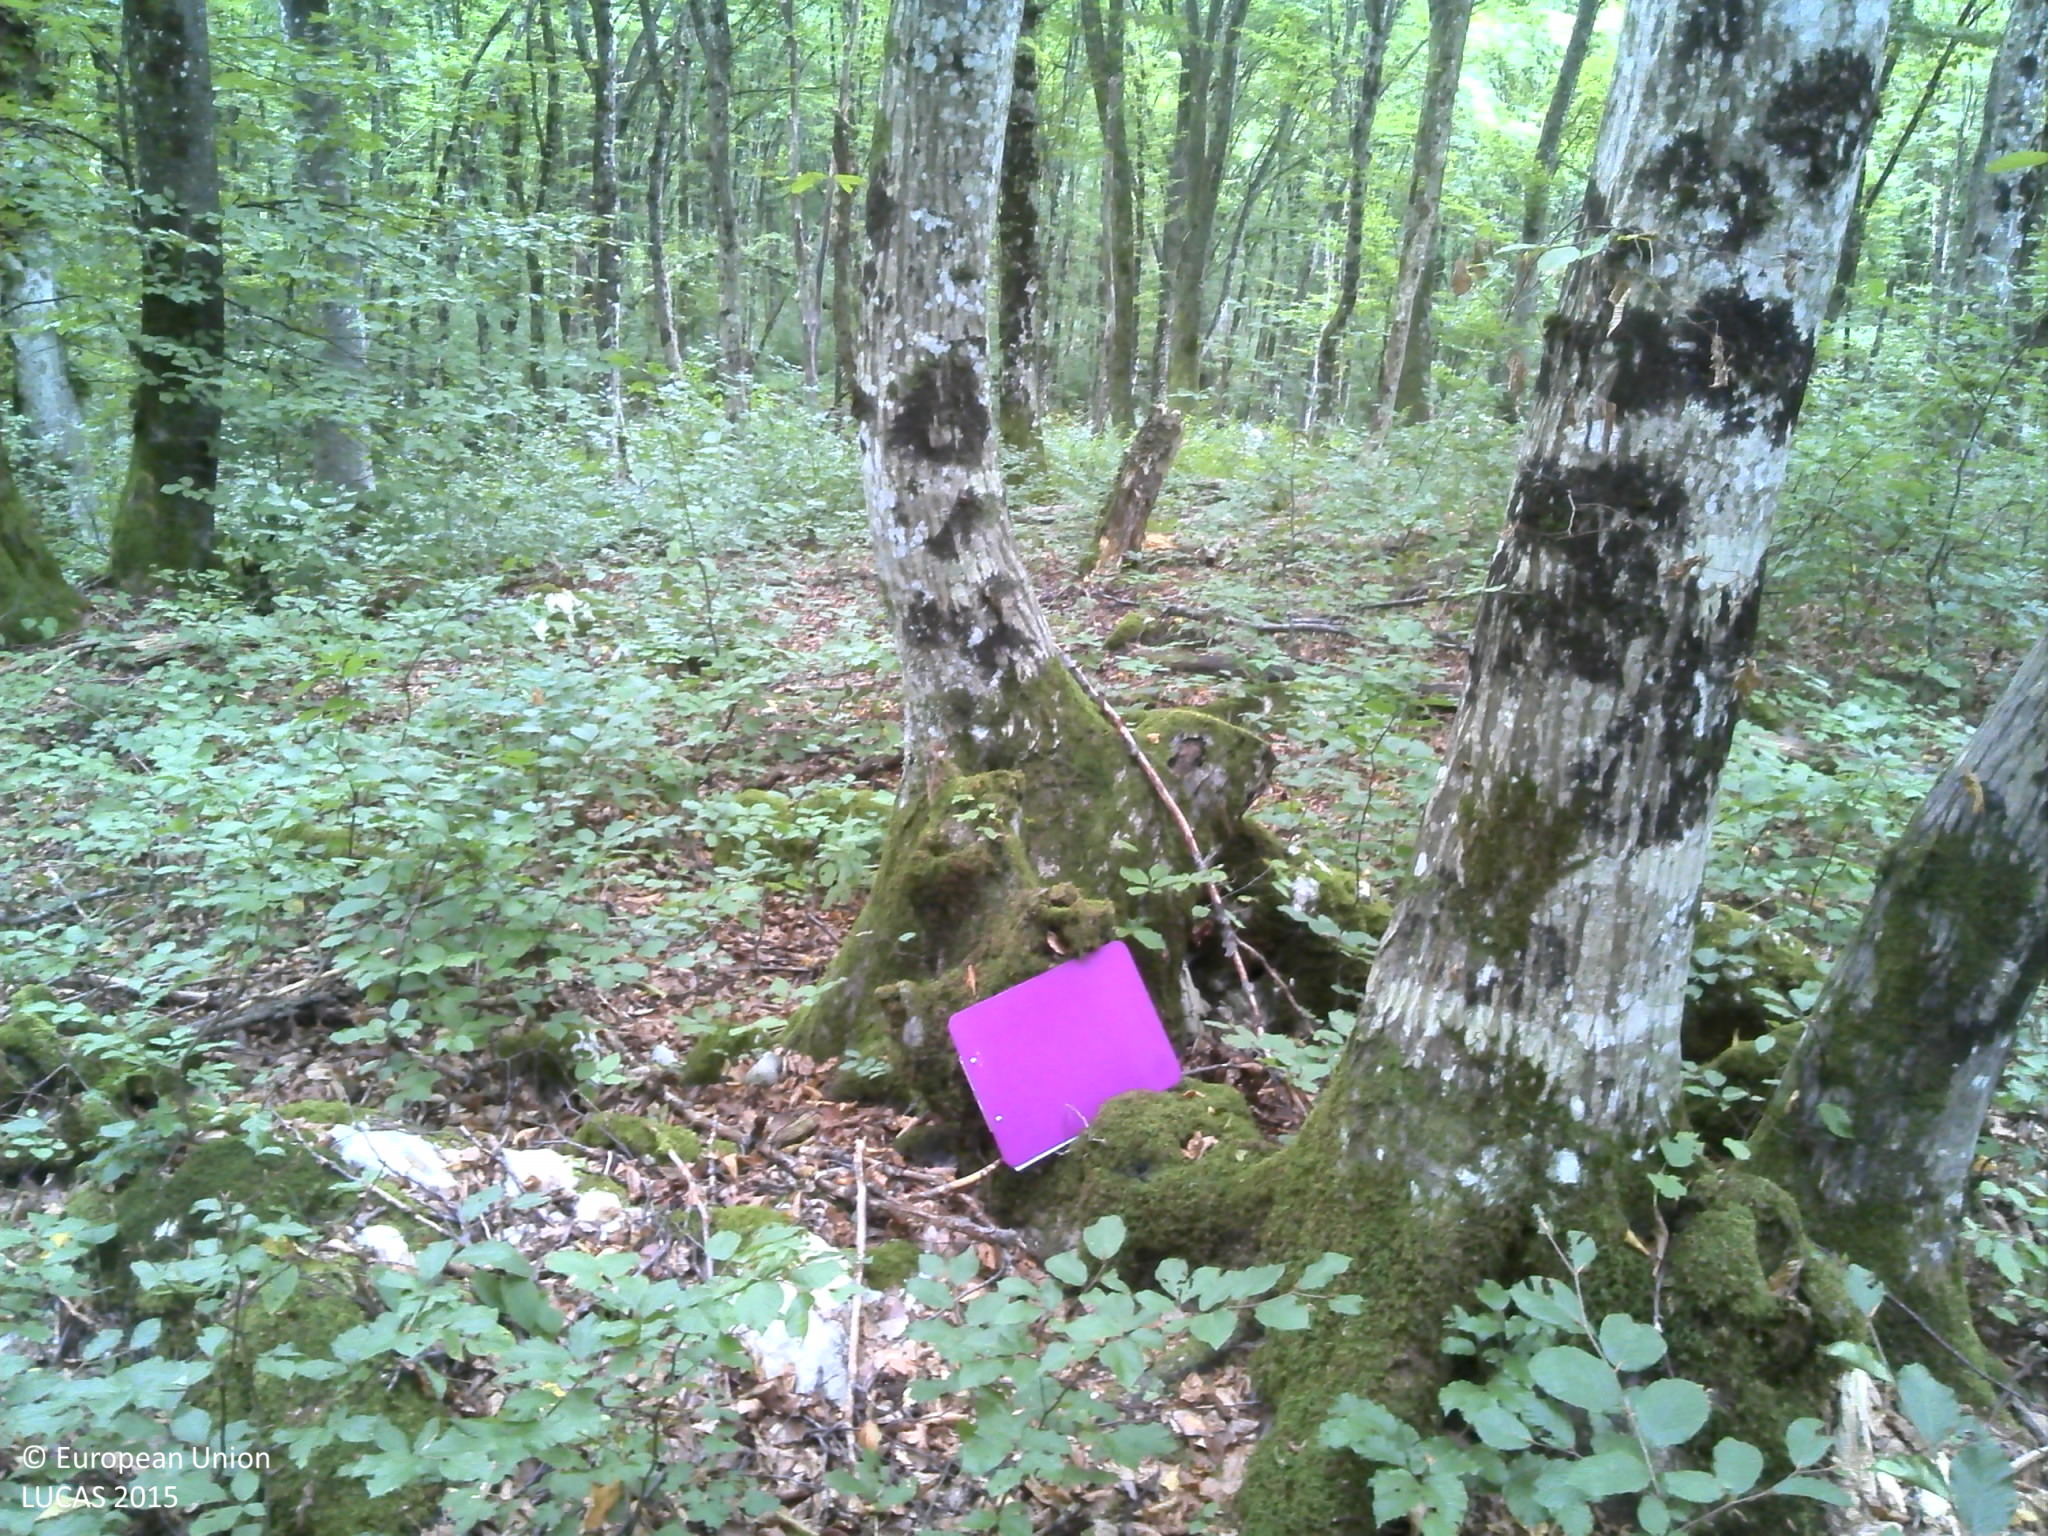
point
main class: Woodland
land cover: Broadleaved woodland
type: acidophilous oak and oak-birch forest
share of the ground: > 75 %
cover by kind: broadleaved forest trees 100 %
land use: Forestry
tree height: > 5 m
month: September
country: HR
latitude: 45.4101
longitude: 15.2471
